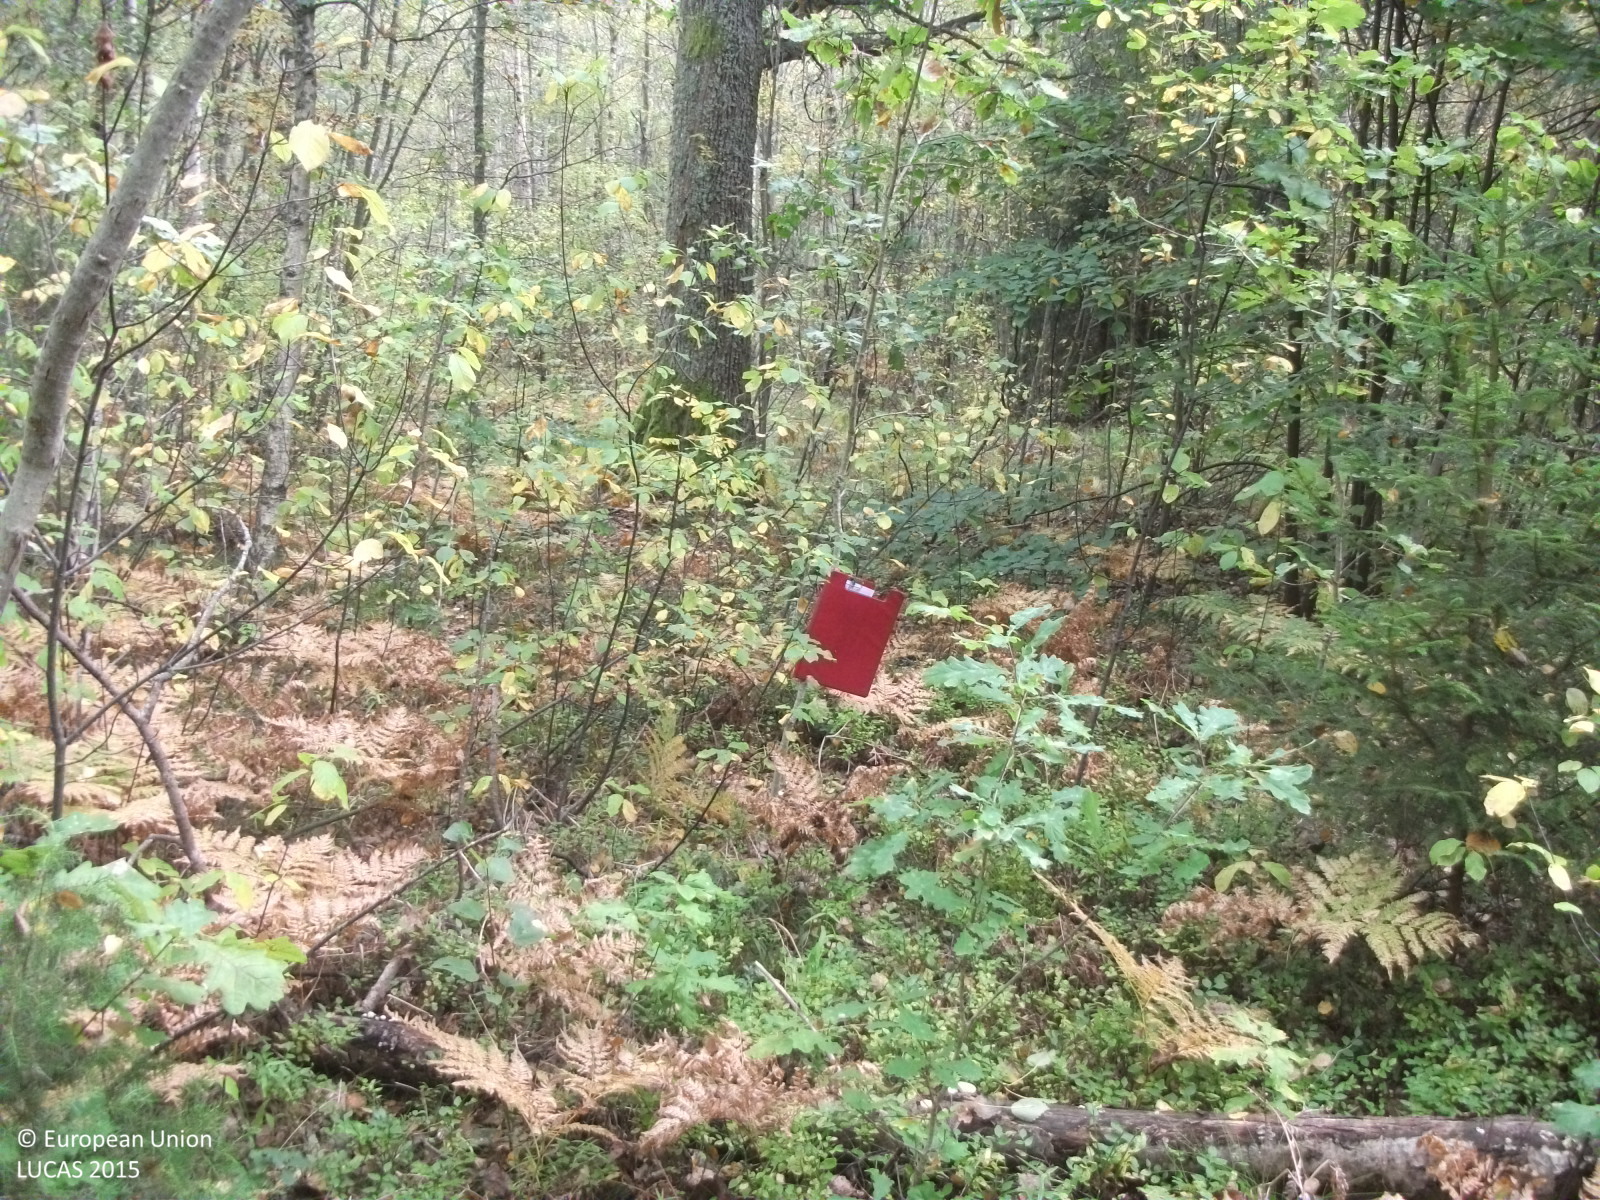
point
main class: Woodland
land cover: Broadleaved woodland
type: non-riverine alder, birch or aspen forest
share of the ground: > 75 %
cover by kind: broadleaved forest trees 85 %, coniferous forest trees 5 %, shrubs 5 %, herbaceous plants 5 %
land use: Forestry
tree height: > 5 m
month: September
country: LV
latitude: 57.8667
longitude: 24.5014
